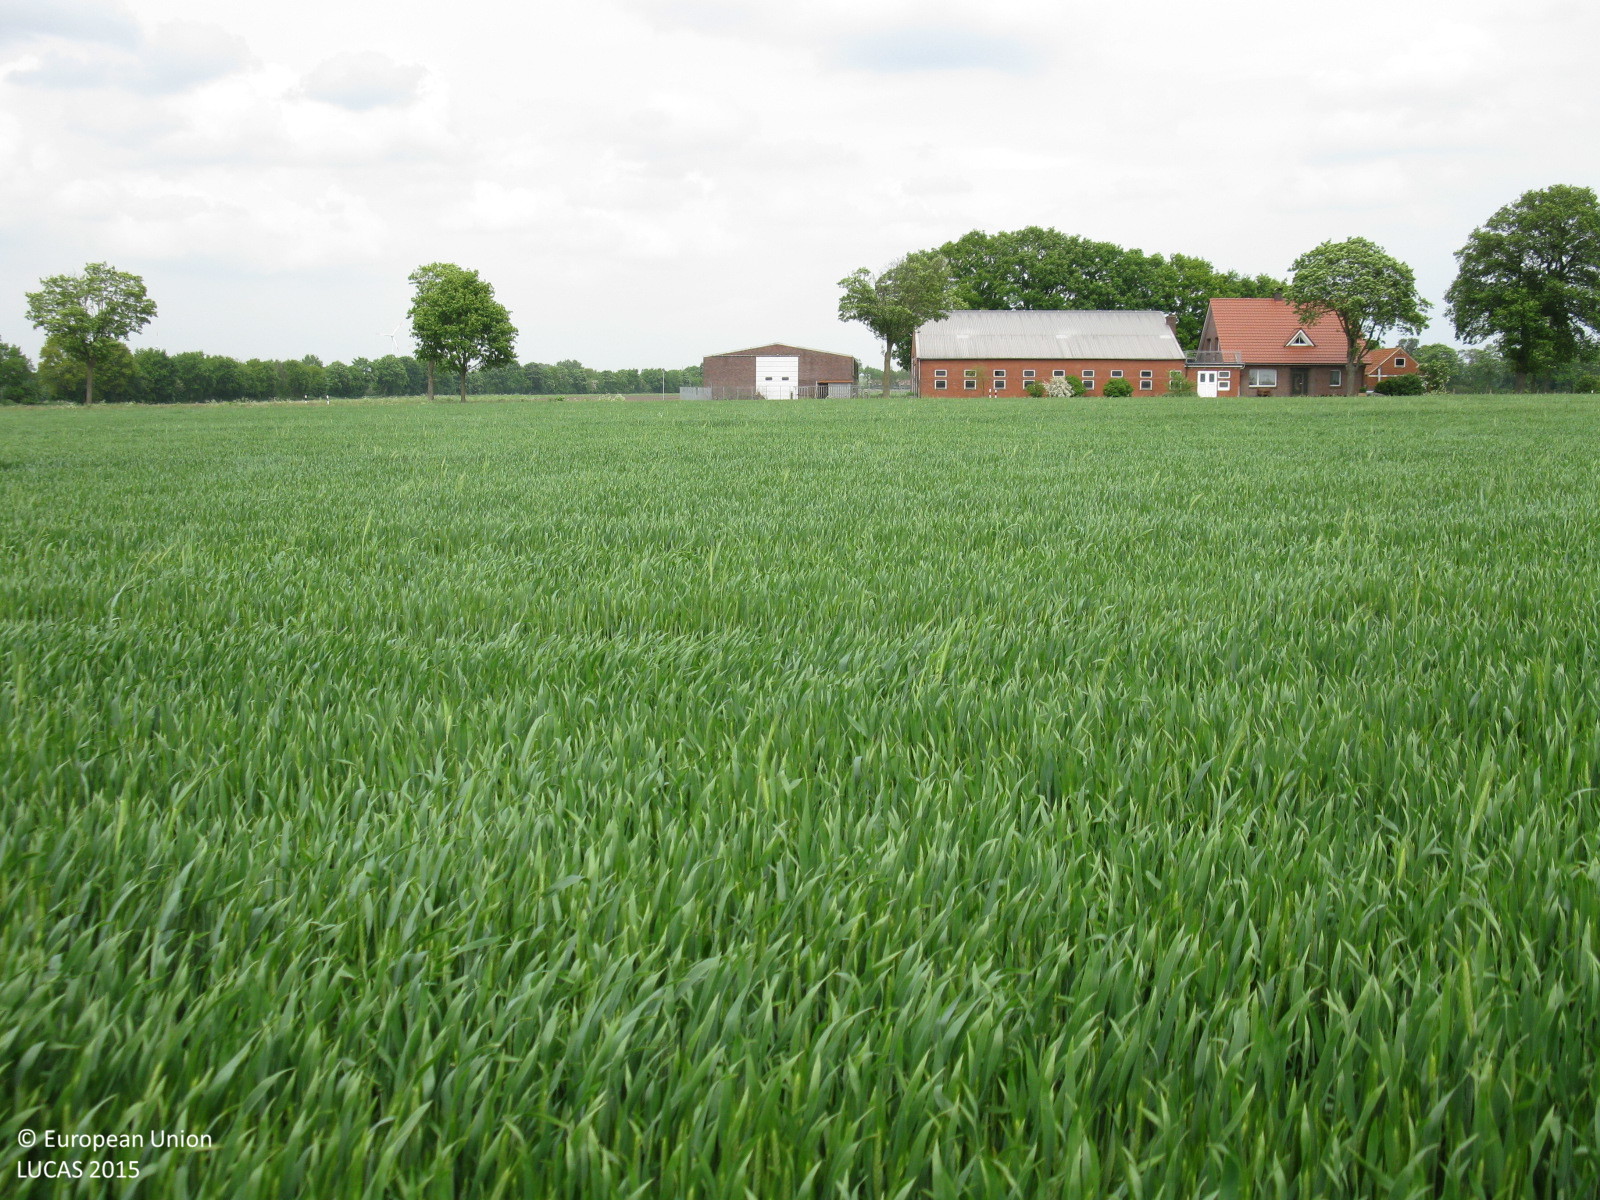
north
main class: Cropland
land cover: Triticale
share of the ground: > 75 %
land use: Agriculture (excluding fallow land and kitchen gardens)
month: May
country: DE
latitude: 52.9963
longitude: 7.3931
